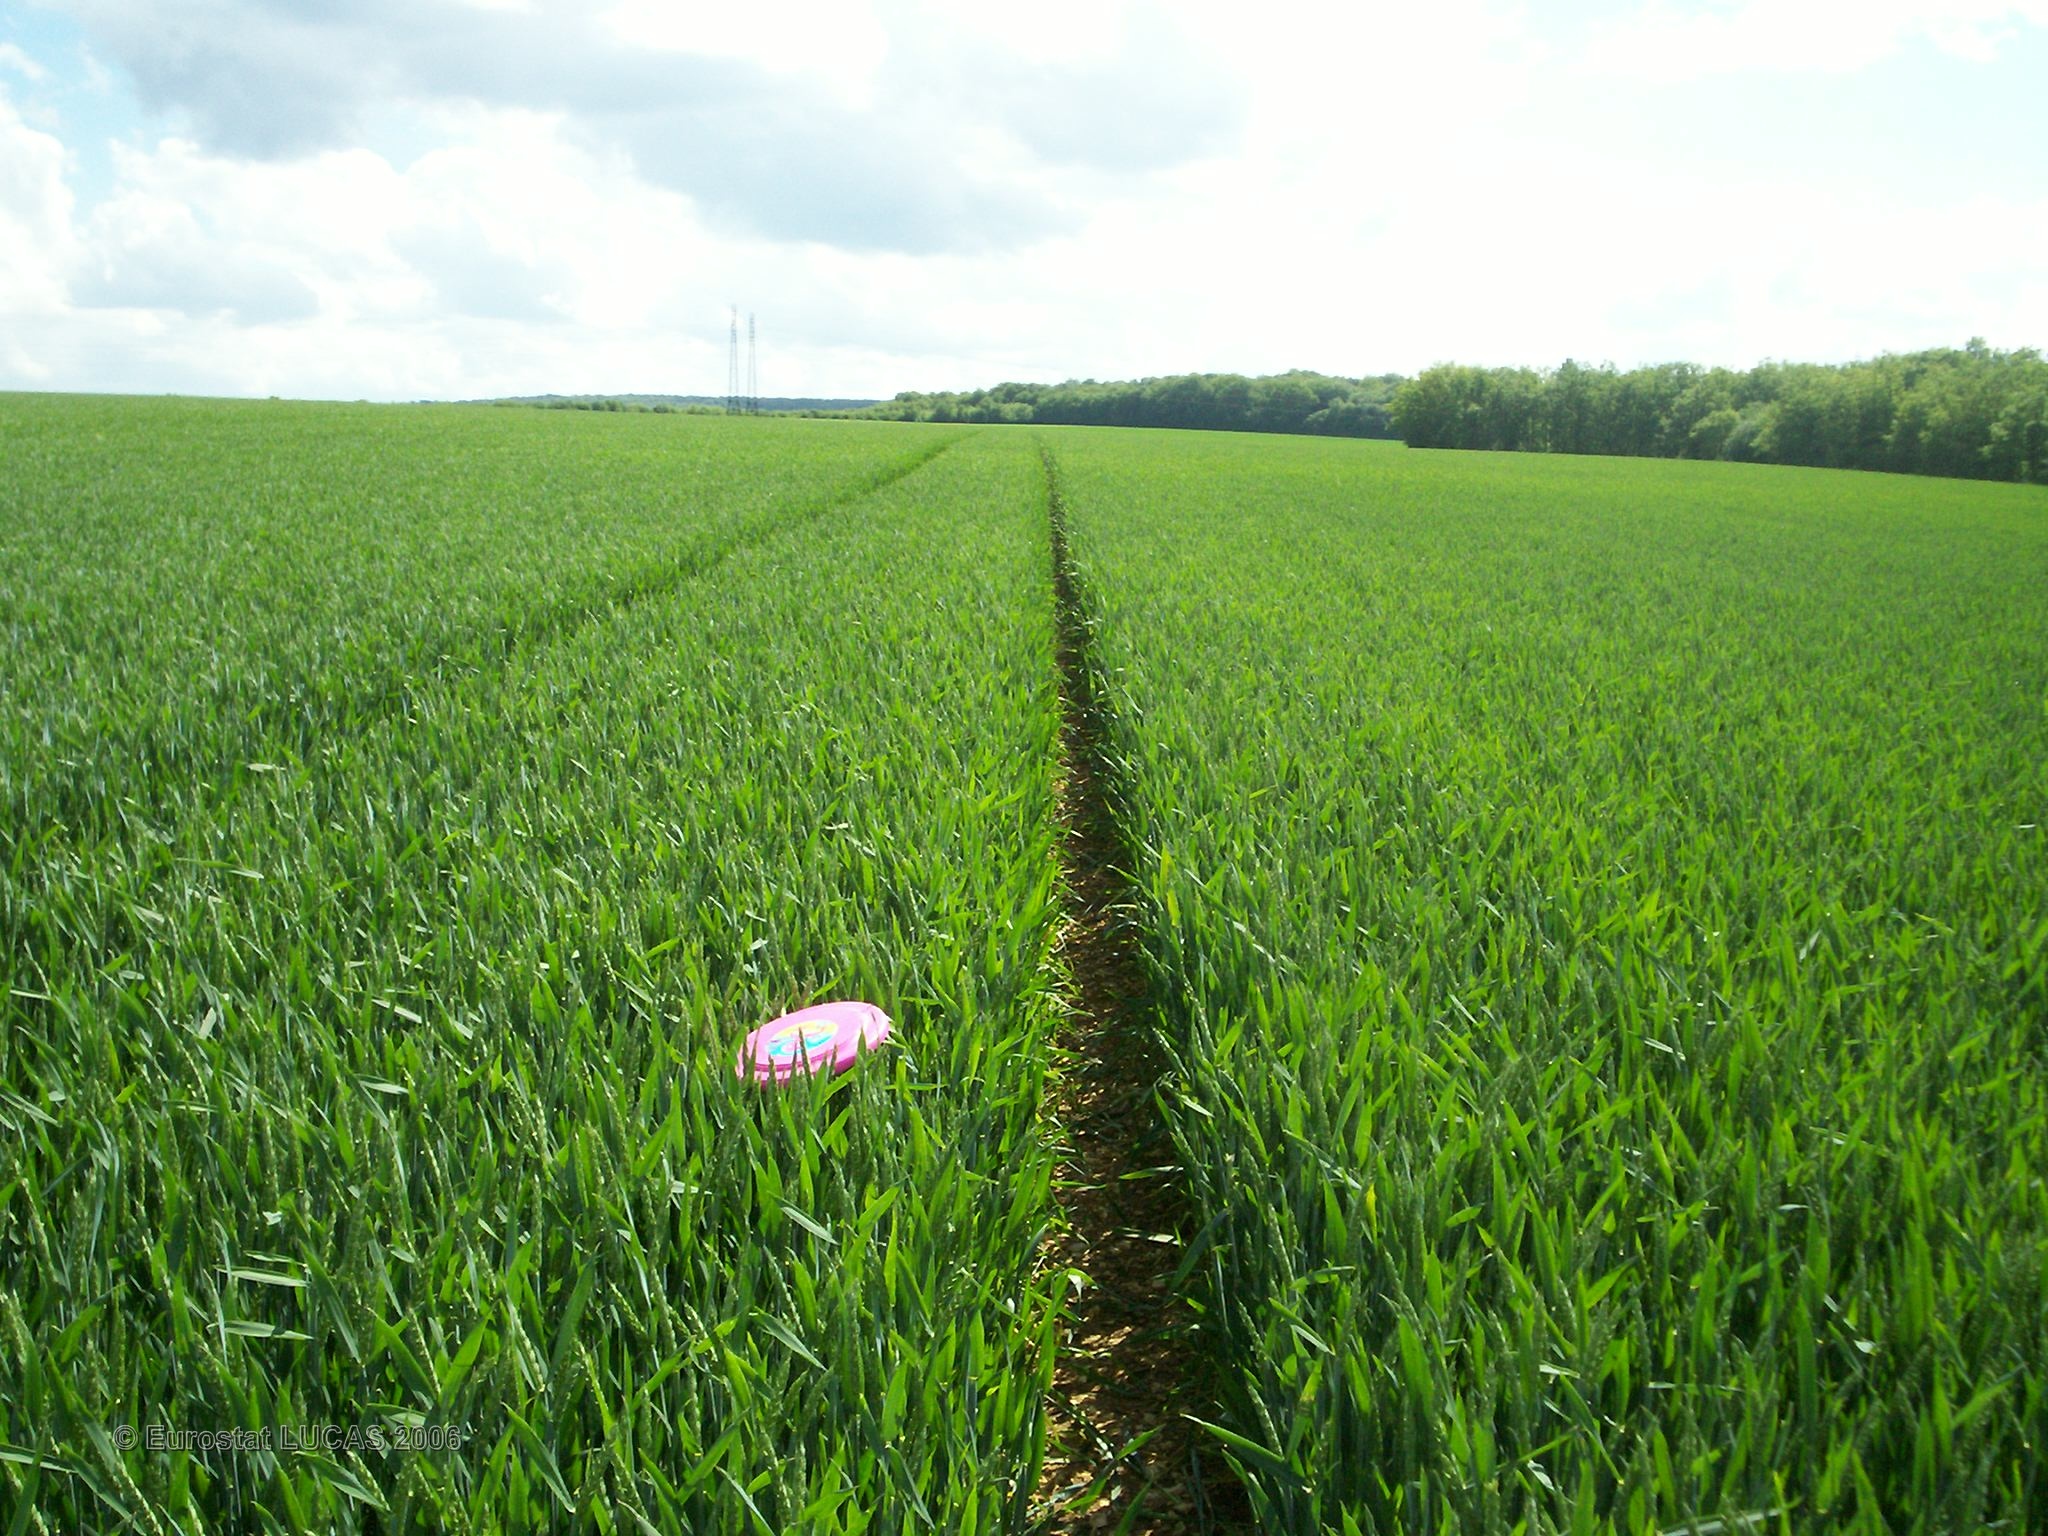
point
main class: Cropland
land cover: Common wheat
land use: Agriculture (excluding fallow land and kitchen gardens)
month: May
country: FR
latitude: 47.8464
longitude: 4.0506
